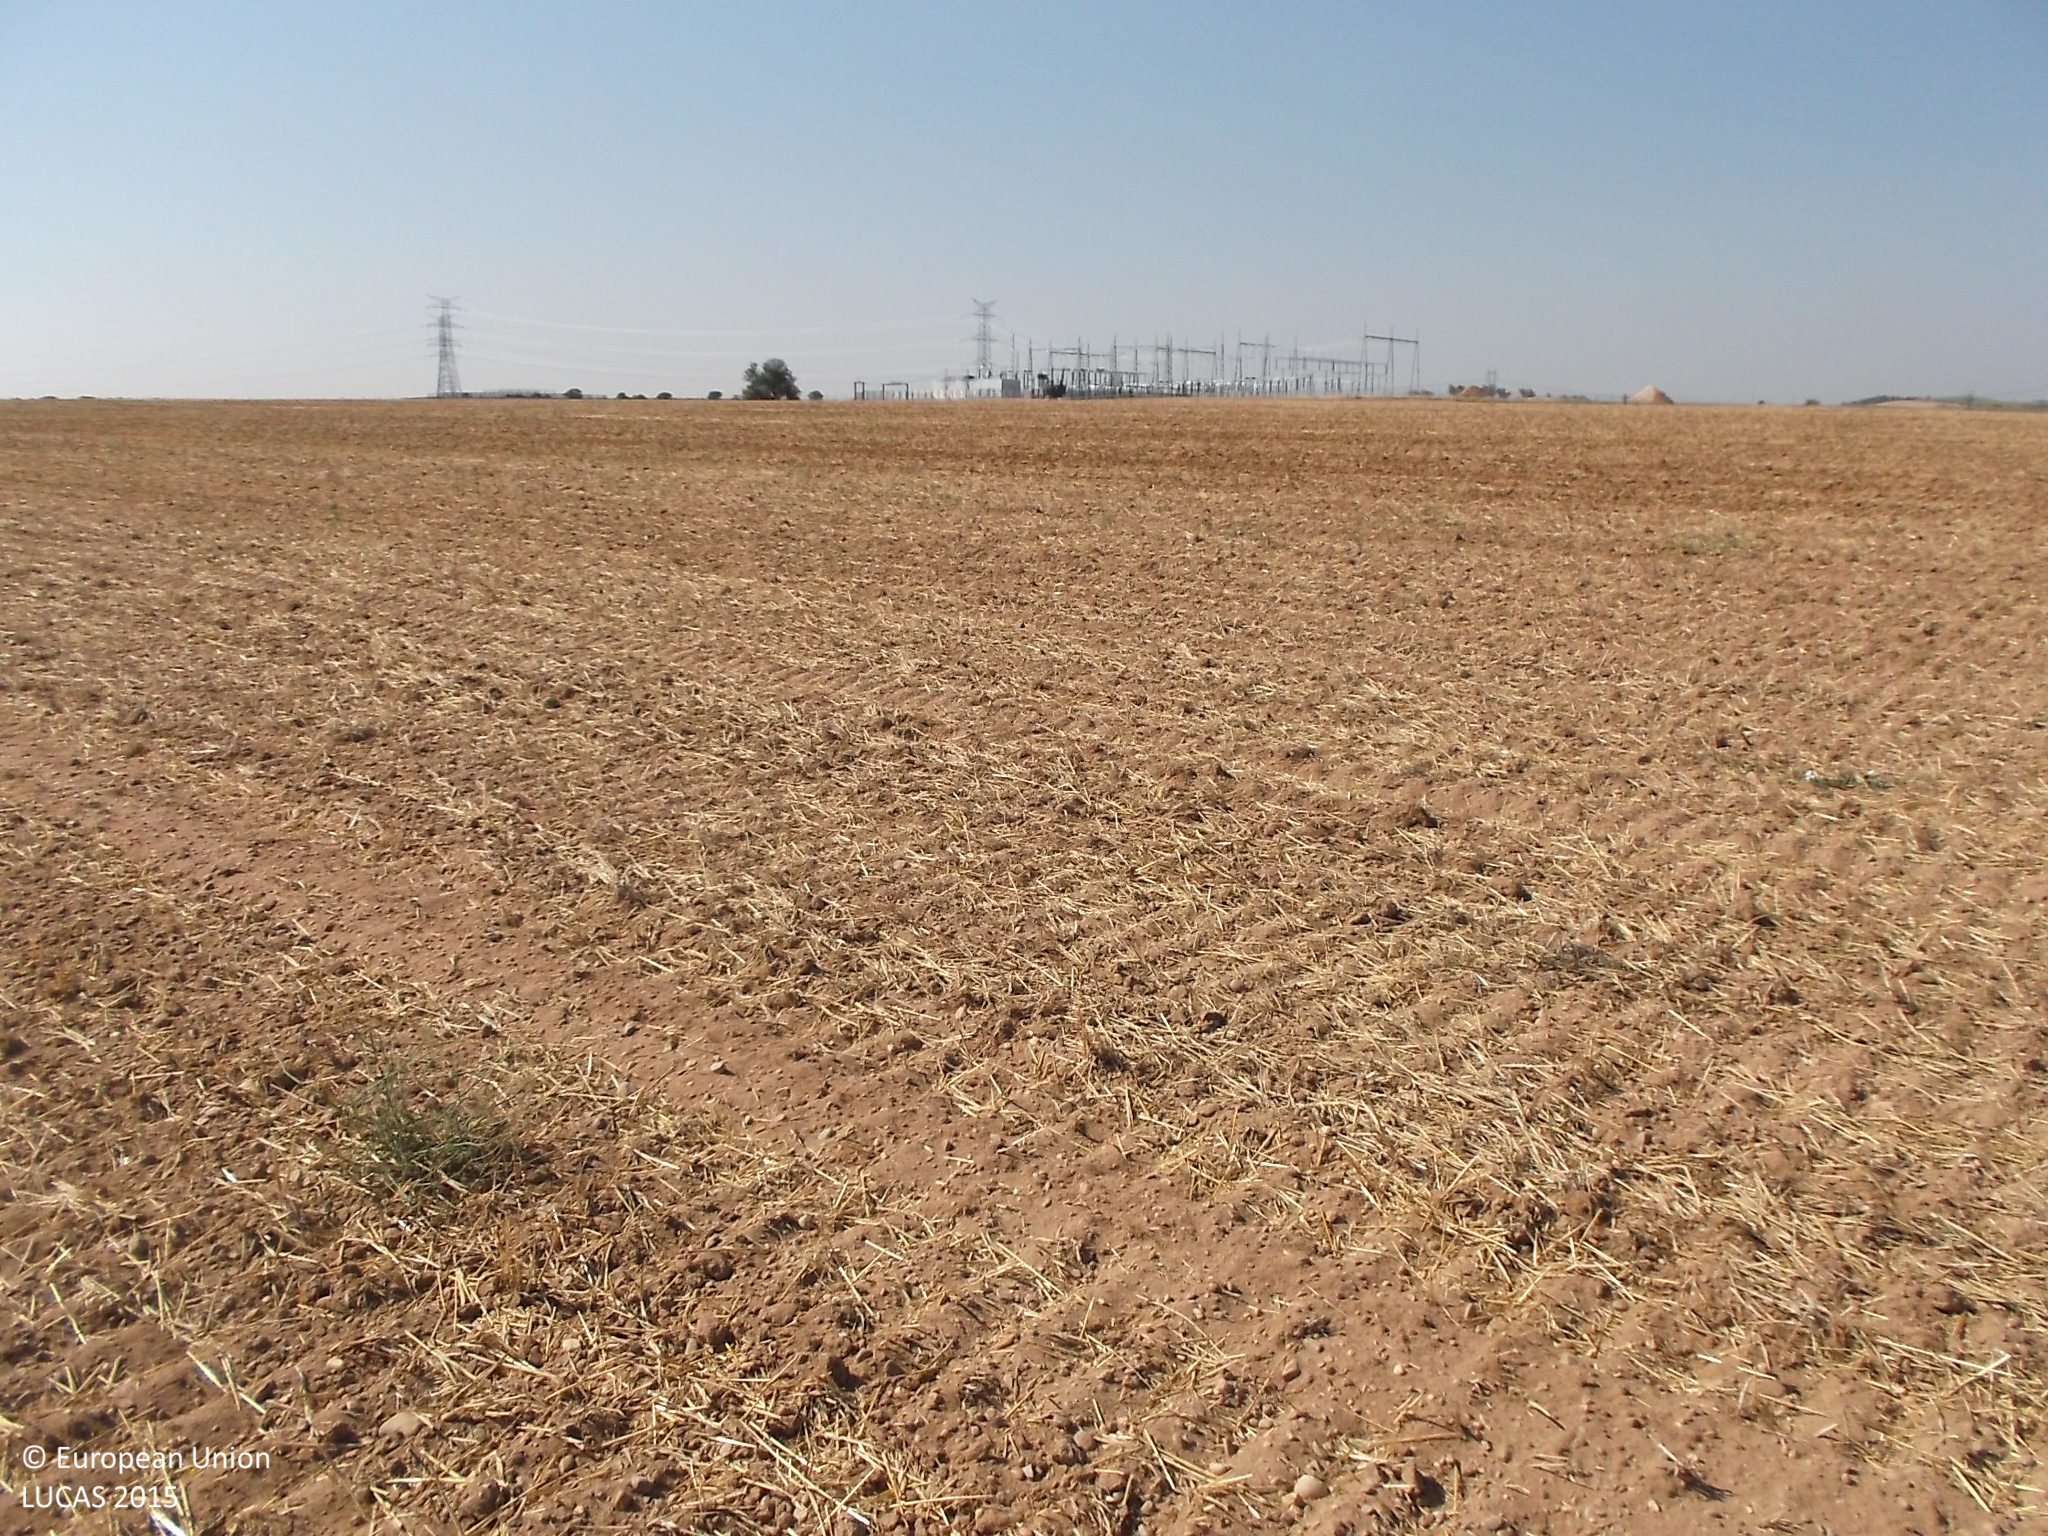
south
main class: Cropland
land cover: Oats
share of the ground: < 10 %
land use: Agriculture (excluding fallow land and kitchen gardens)
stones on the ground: 10 - 25 %
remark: Harvested field
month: July
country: ES
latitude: 41.4551
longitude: -5.3655
